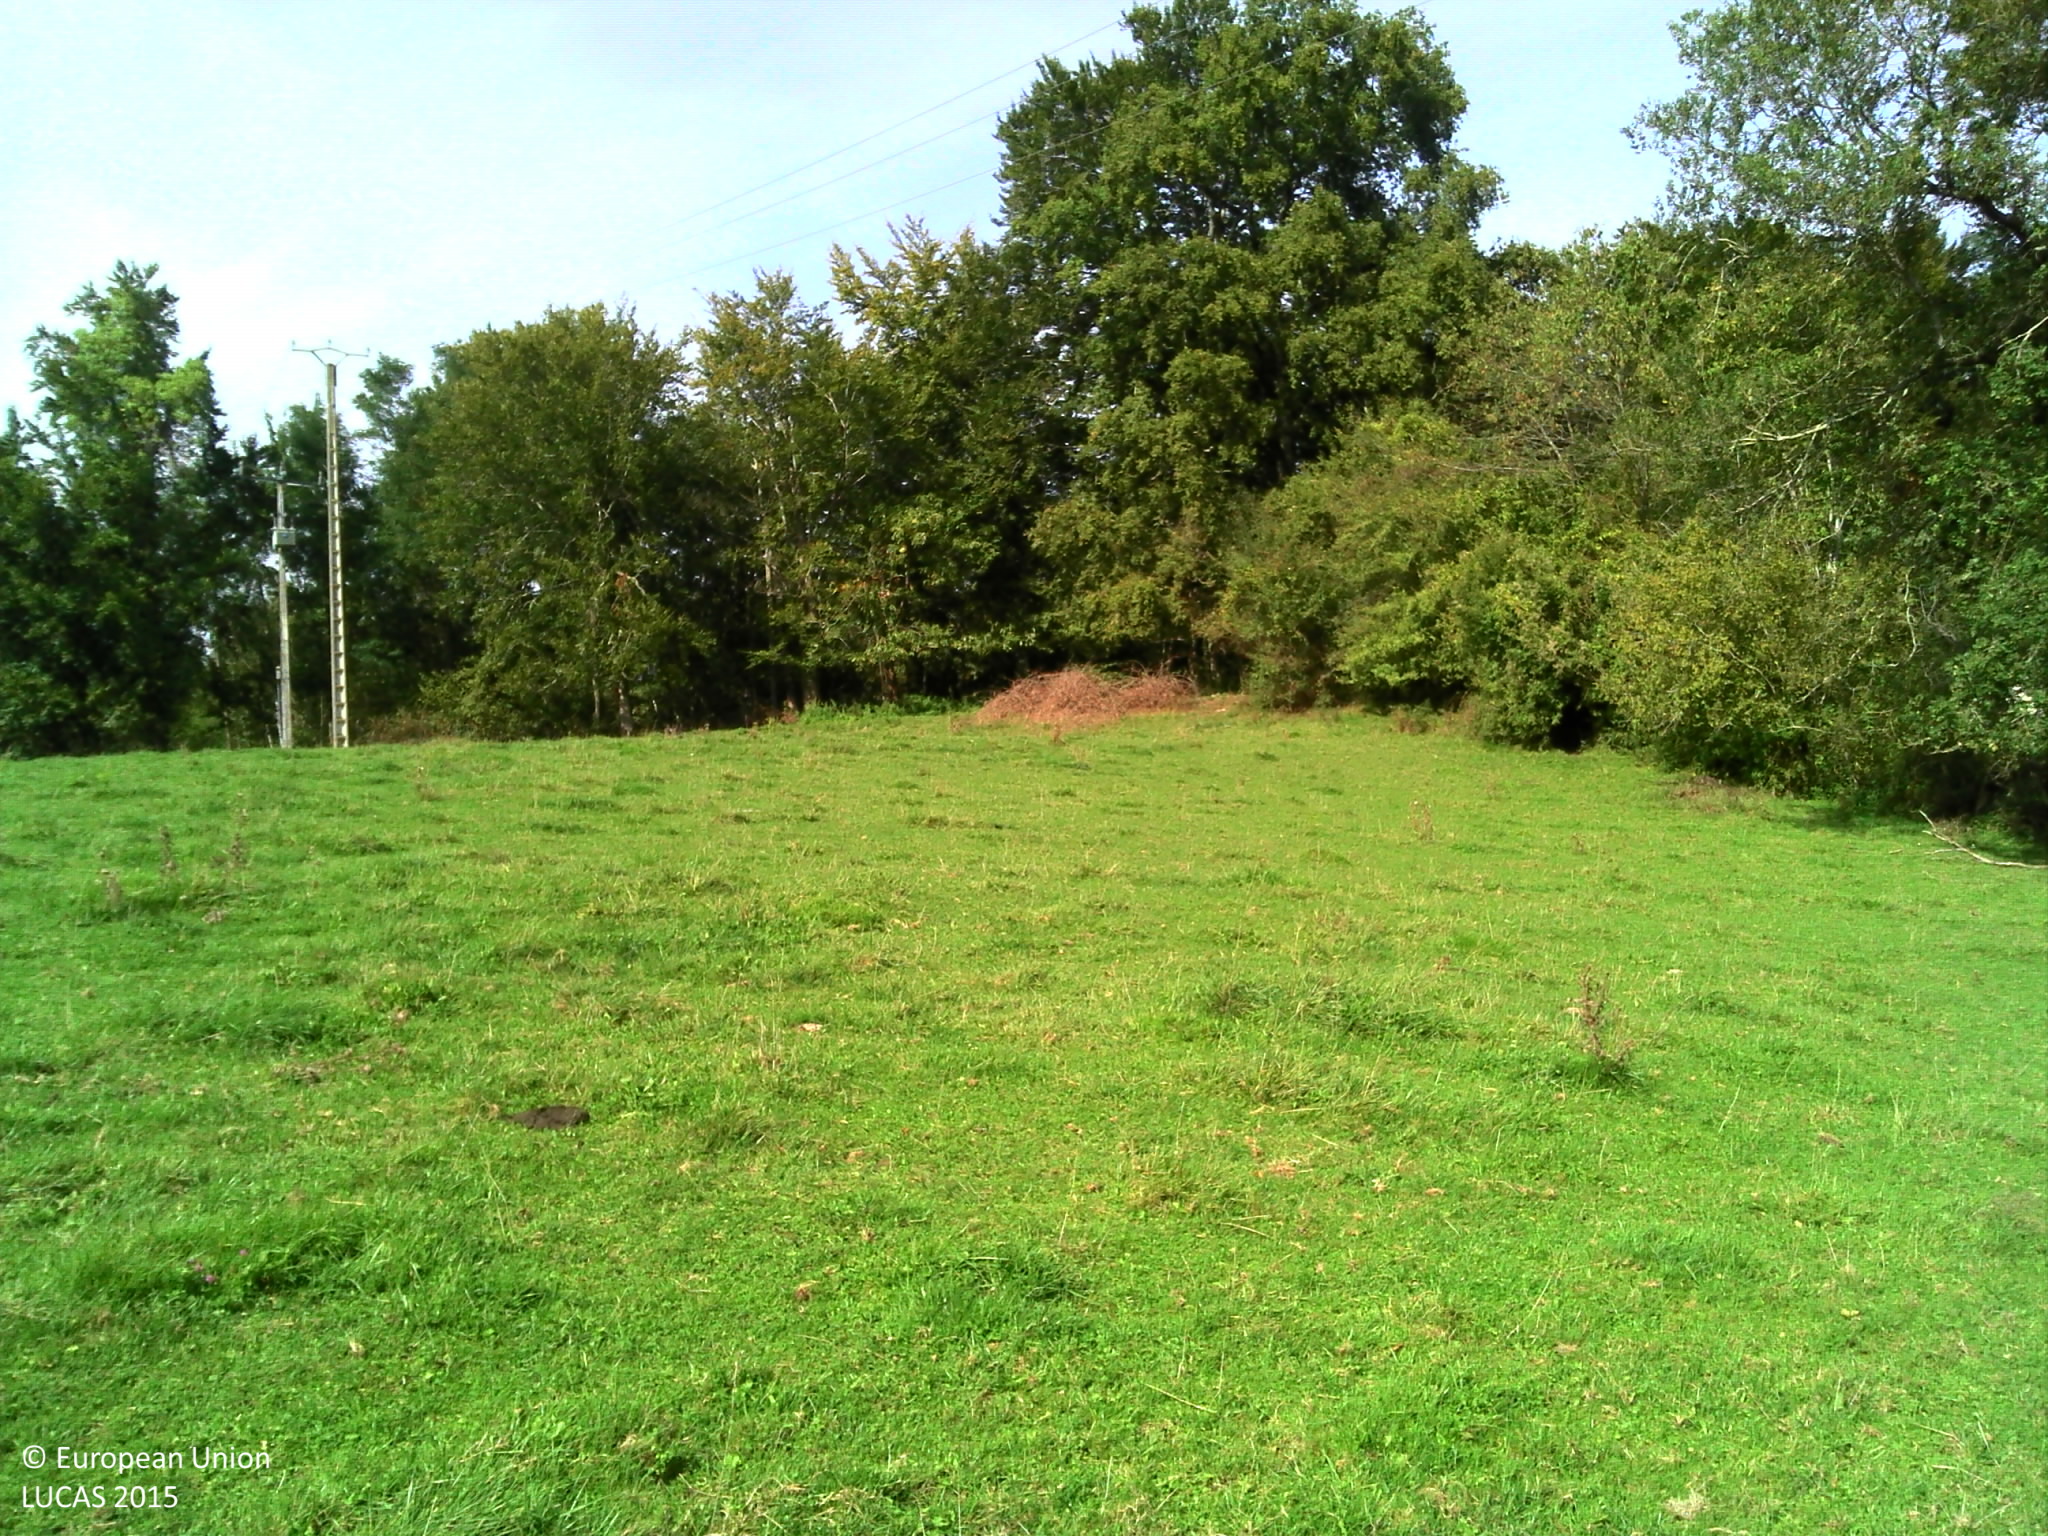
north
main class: Grassland
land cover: Grassland without tree/shrub cover
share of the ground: > 75 %
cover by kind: herbaceous plants 100 %
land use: Agriculture (excluding fallow land and kitchen gardens)
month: September
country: FR
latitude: 43.2207
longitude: -0.4589
